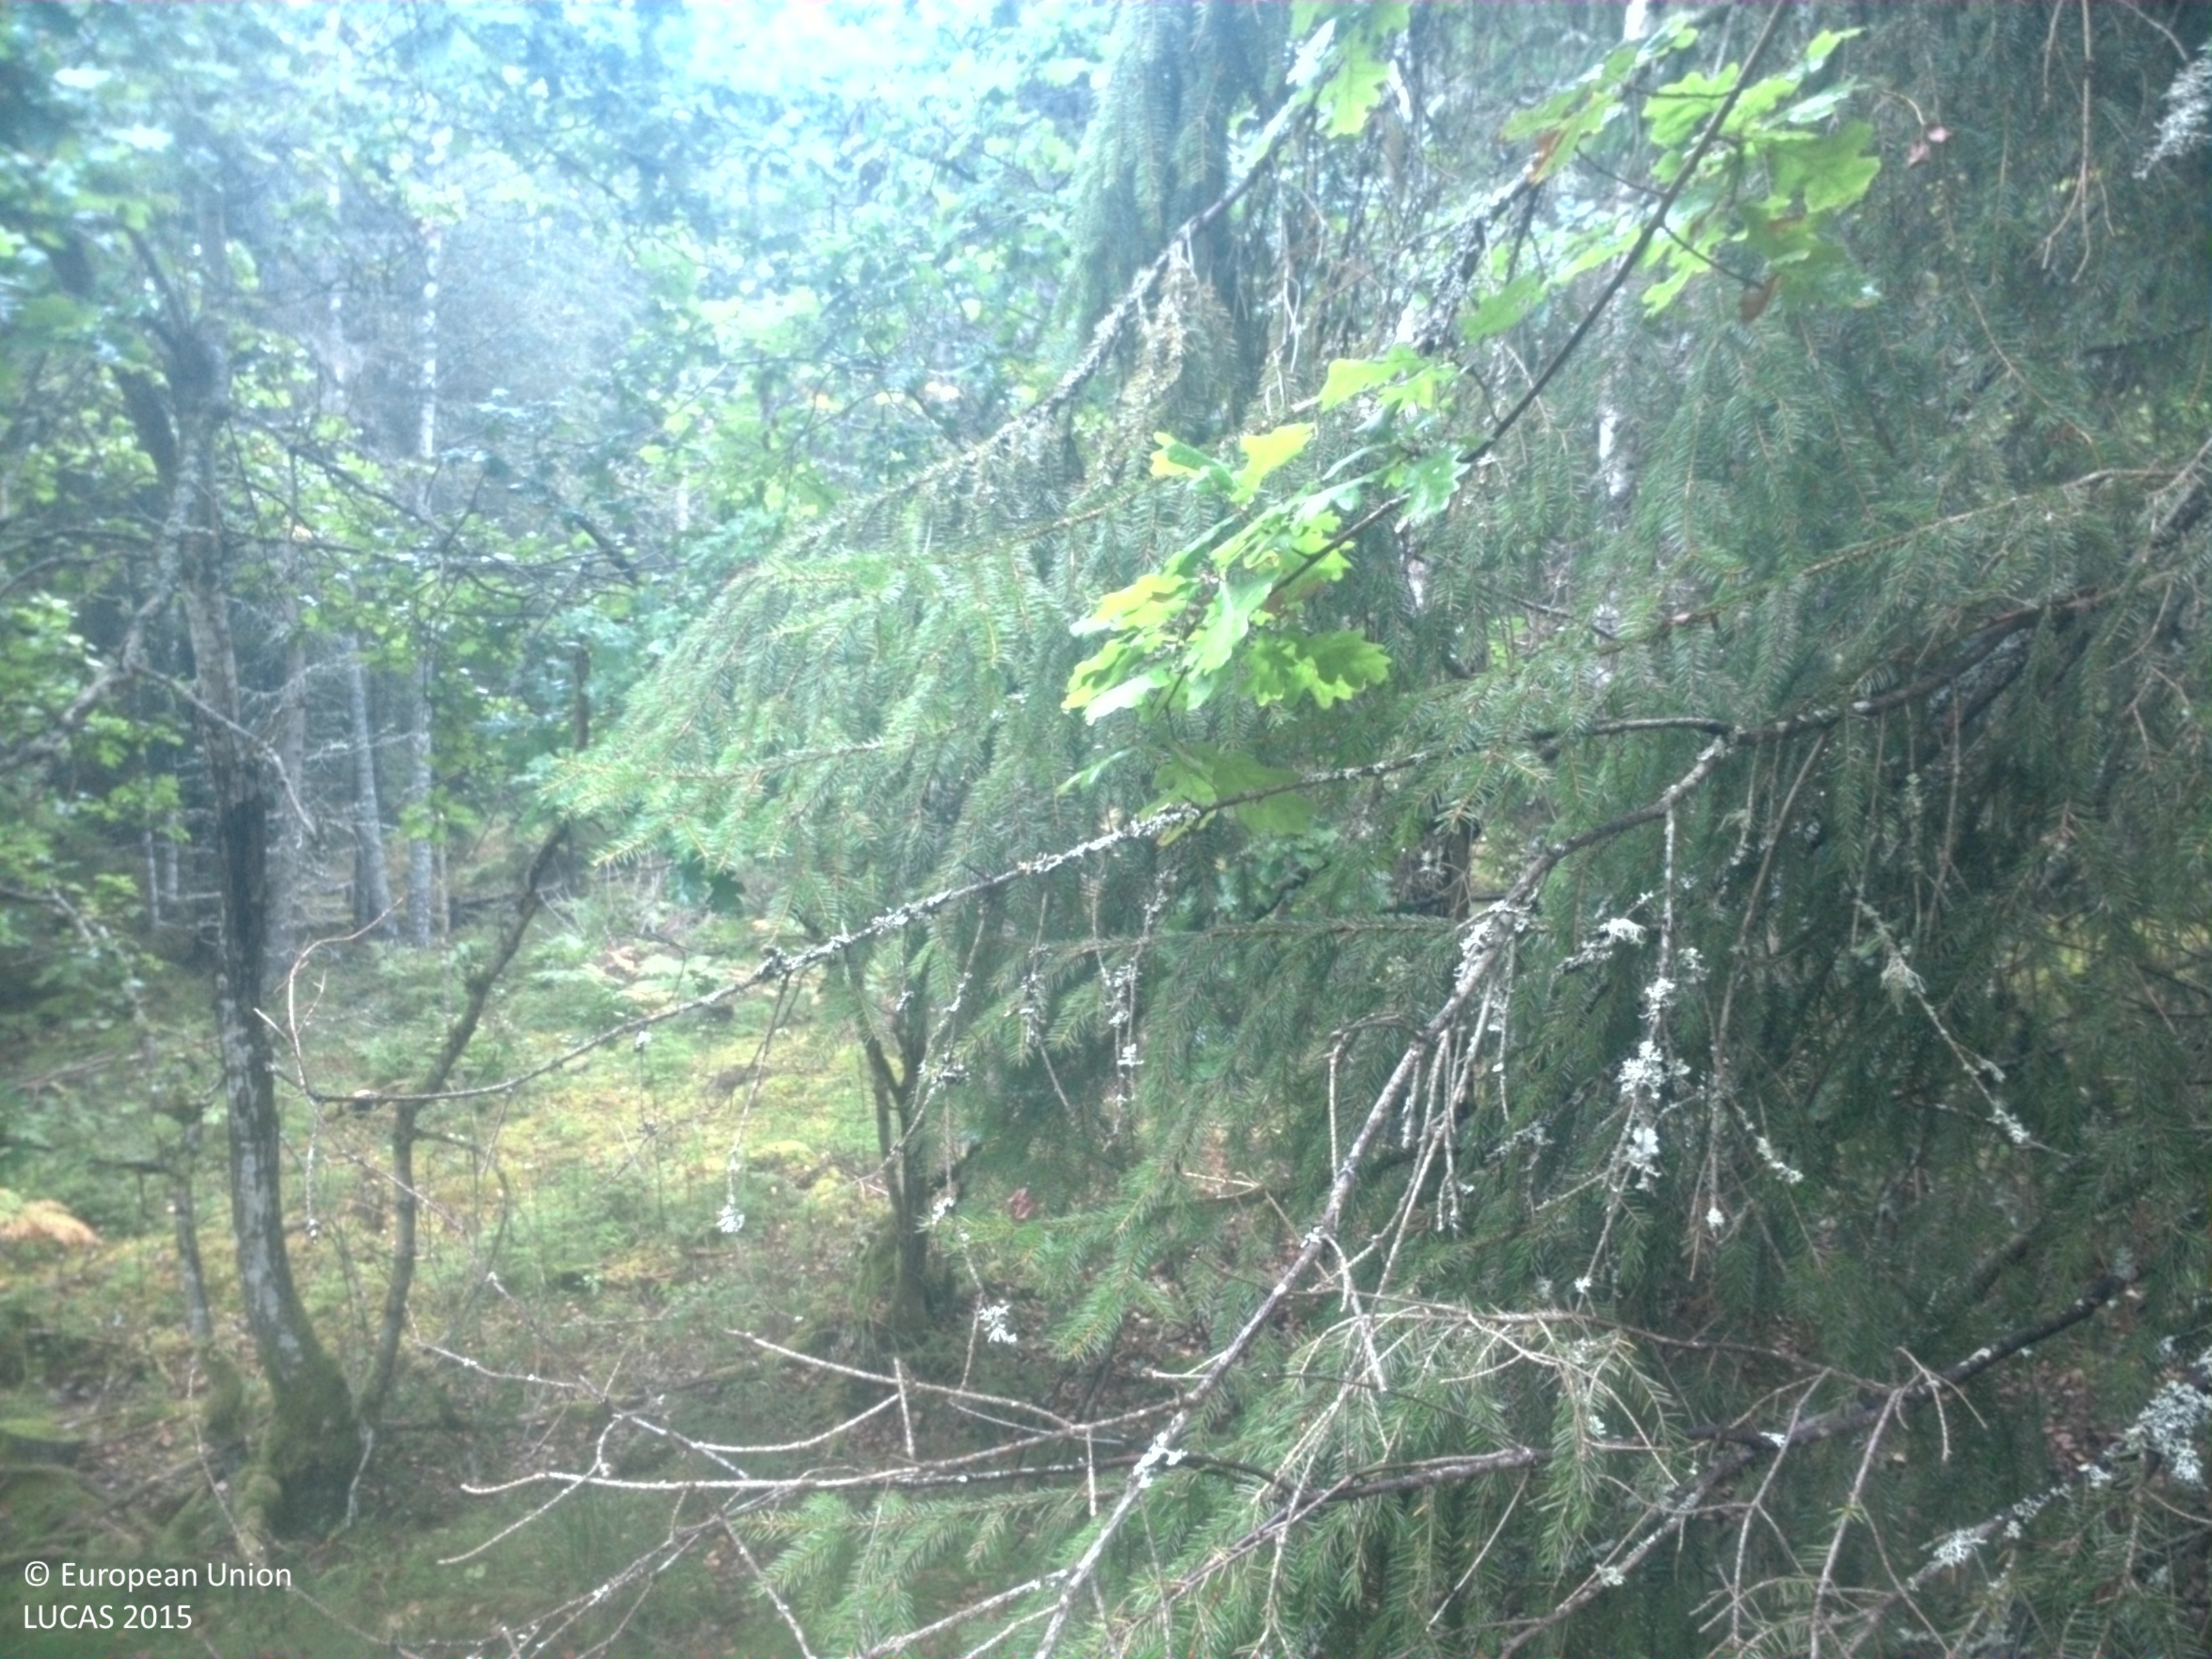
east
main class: Woodland
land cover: Spruce dominated coniferous woodland
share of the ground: 25 - 50 %
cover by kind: coniferous forest trees 35 %, herbaceous plants 30 %, lichens and mosses 30 %, broadleaved forest trees 5 %
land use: Forestry
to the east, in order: Spruce dominated coniferous woodland; Spruce dominated mixed woodland; Spruce dominated coniferous woodland; Ditches and canals; Spruce dominated mixed woodland; Ditches and canals; Spruce dominated mixed woodland
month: September
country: SE
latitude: 58.8277
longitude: 13.9594
